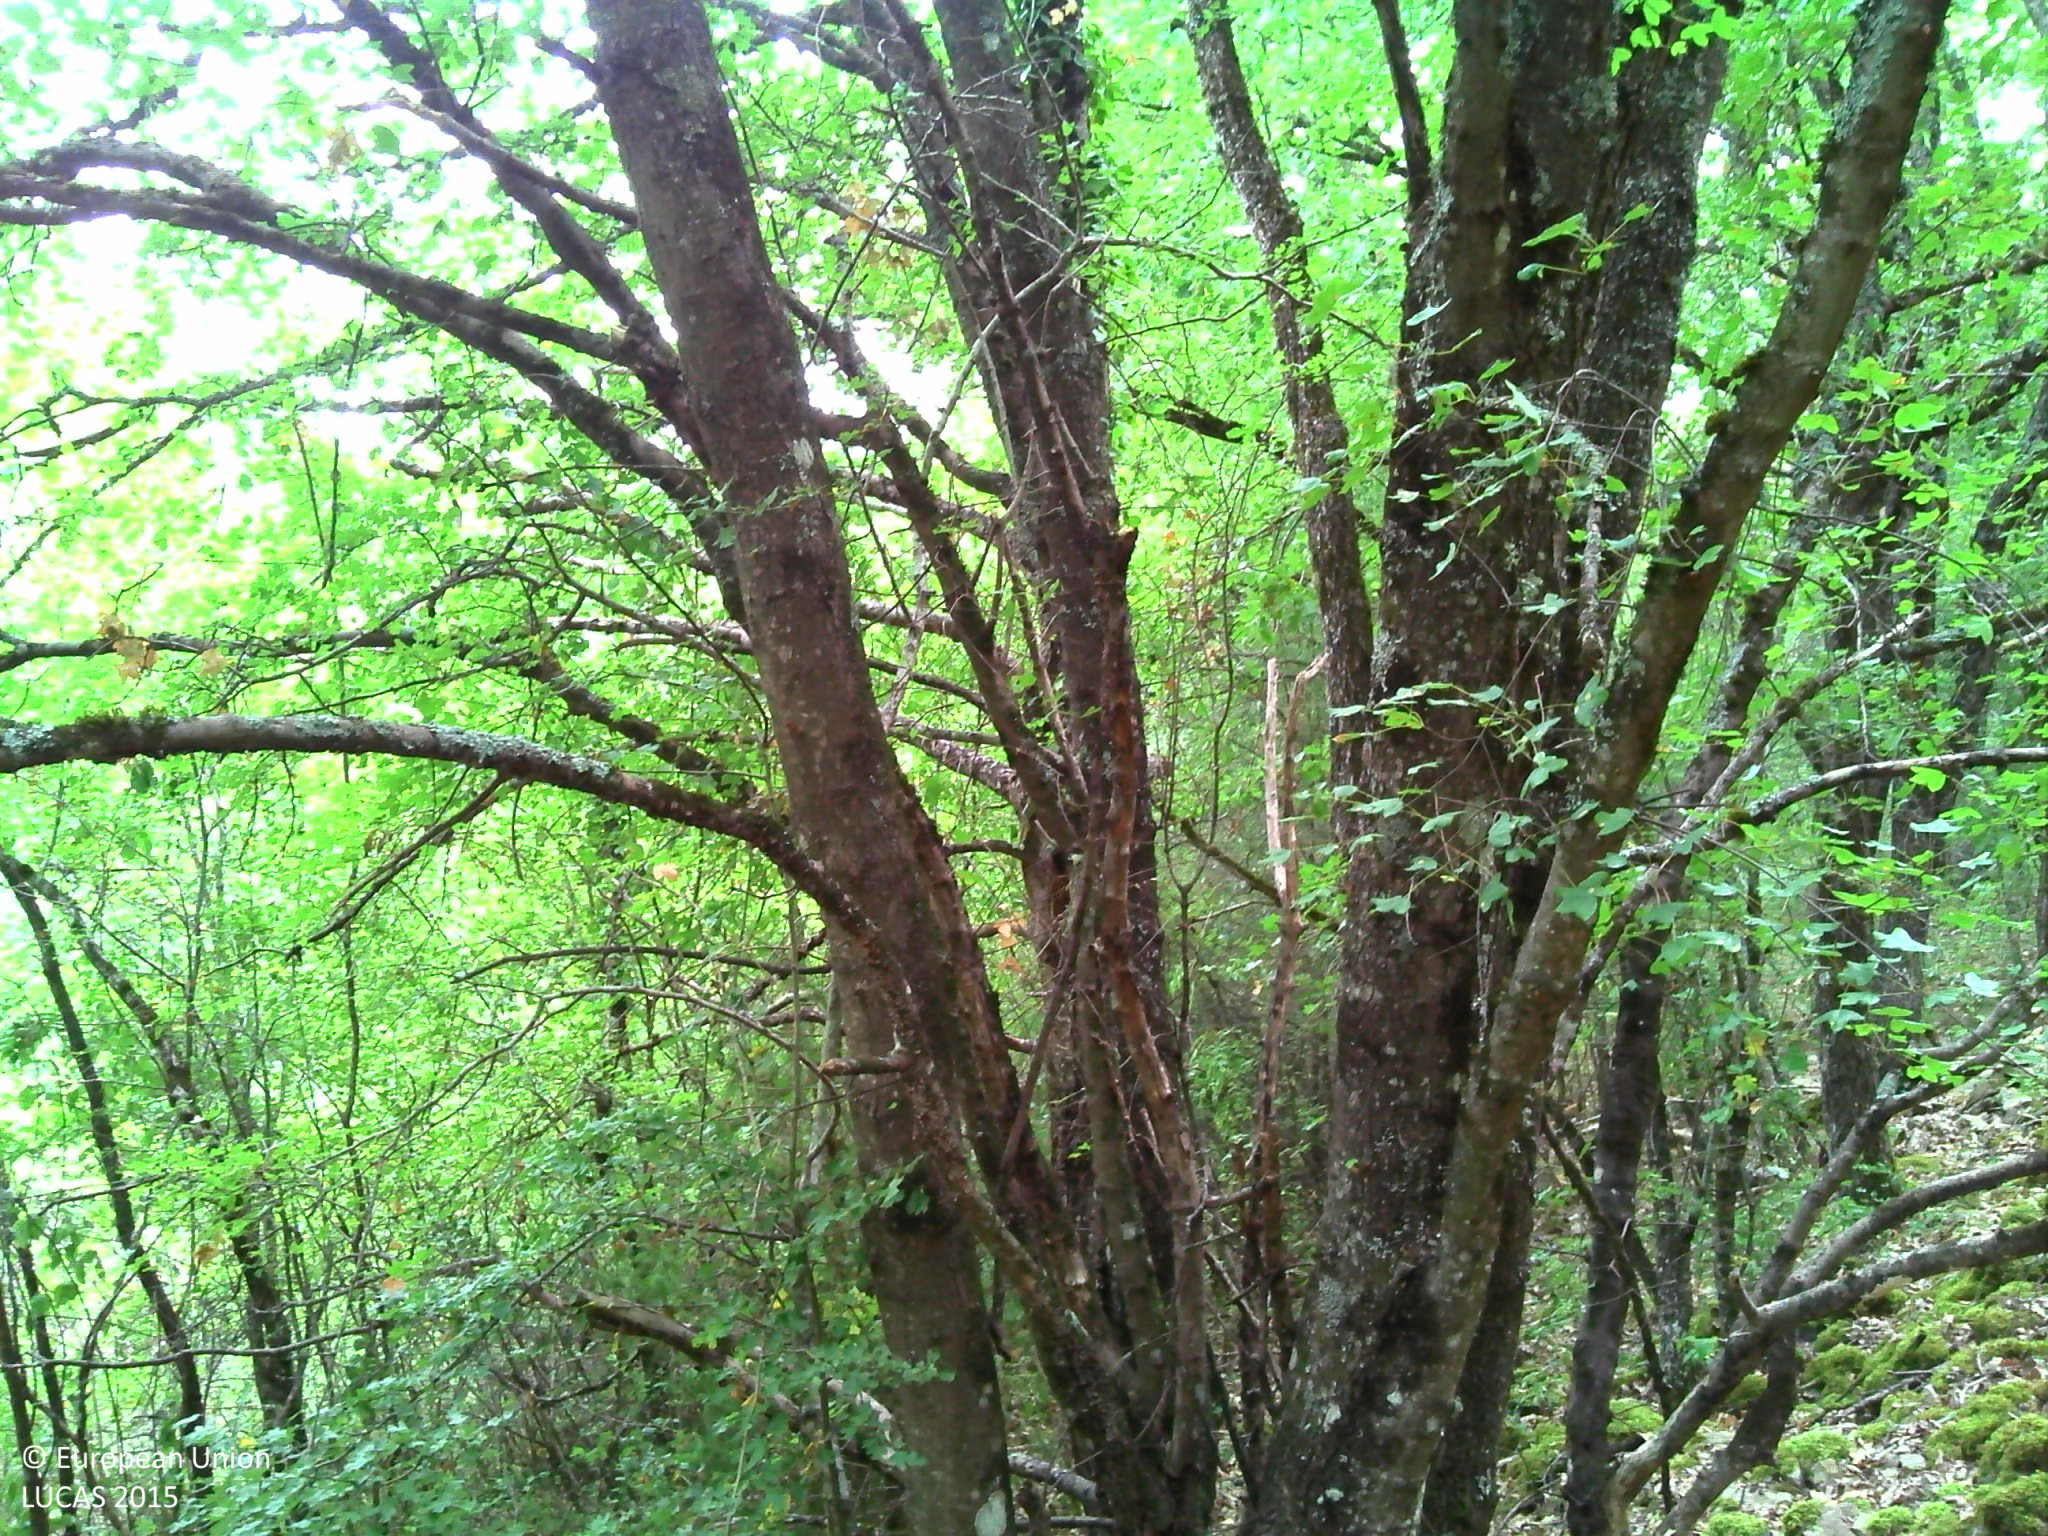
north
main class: Woodland
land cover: Broadleaved woodland
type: mesophytic deciduous forest
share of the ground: > 75 %
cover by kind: broadleaved forest trees 65 %, lichens and mosses 15 %, herbaceous plants 10 %, unconsolidated bare surface 10 %
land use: Forestry
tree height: > 5 m
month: August
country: FR
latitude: 44.0438
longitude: 3.3048
